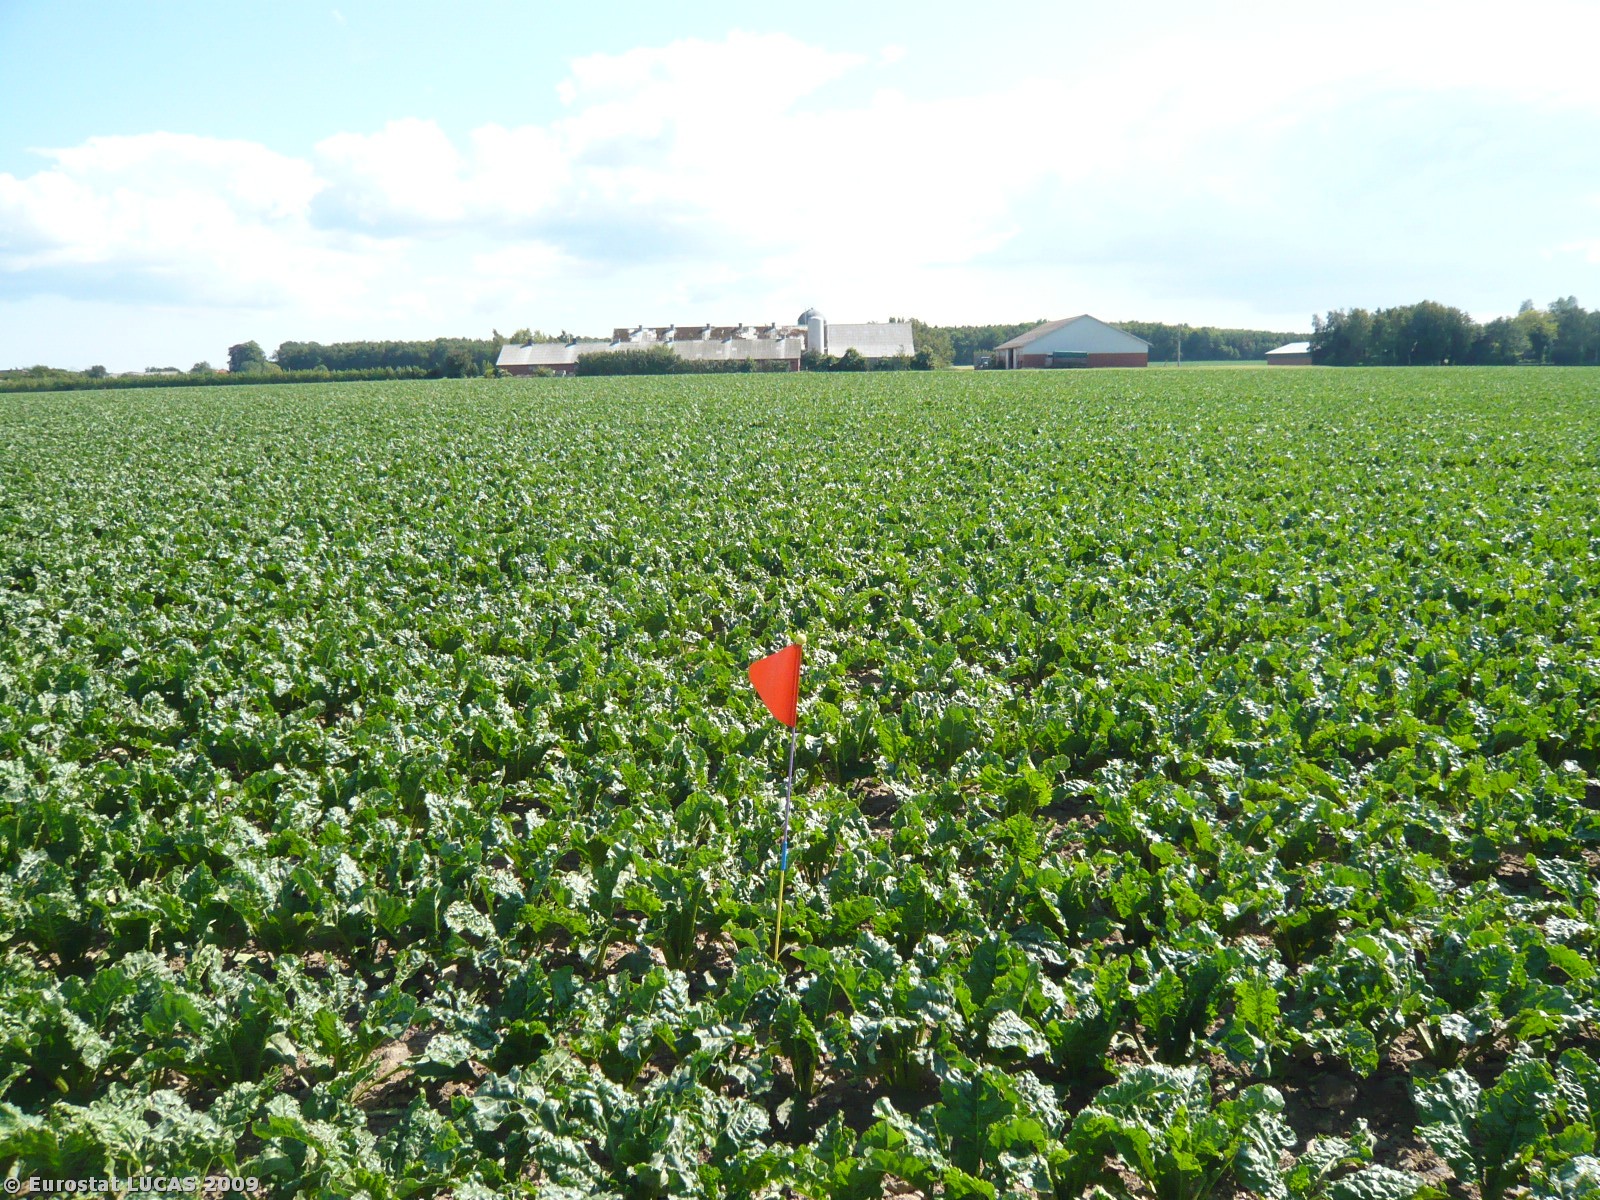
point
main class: Cropland
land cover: Sugar beet
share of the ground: > 75 %
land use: Agriculture (excluding fallow land and kitchen gardens)
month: June
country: DK
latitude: 54.8825
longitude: 11.6667
